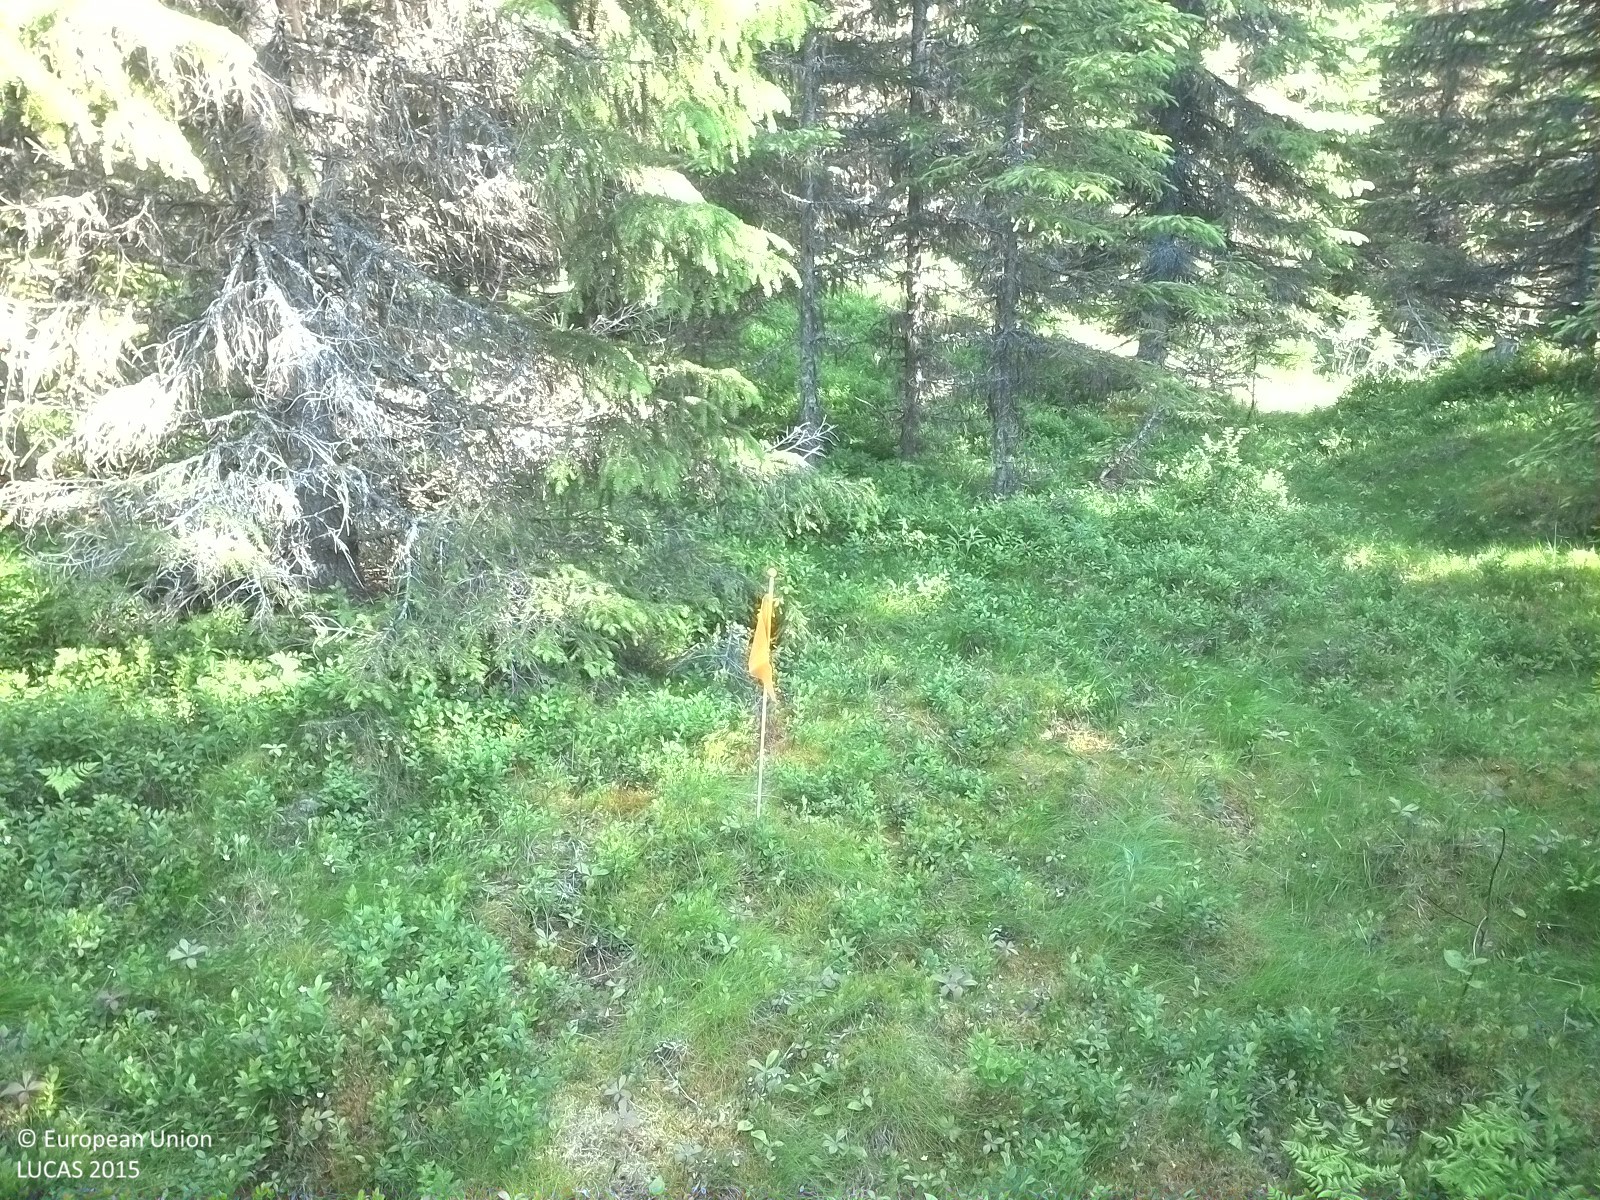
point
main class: Woodland
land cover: Spruce dominated coniferous woodland
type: boreal forest
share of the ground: 50 - 75 %
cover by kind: coniferous forest trees 75 %, shrubs 25 %
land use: Forestry
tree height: > 5 m
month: July
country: SE
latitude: 63.5934
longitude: 15.0746
